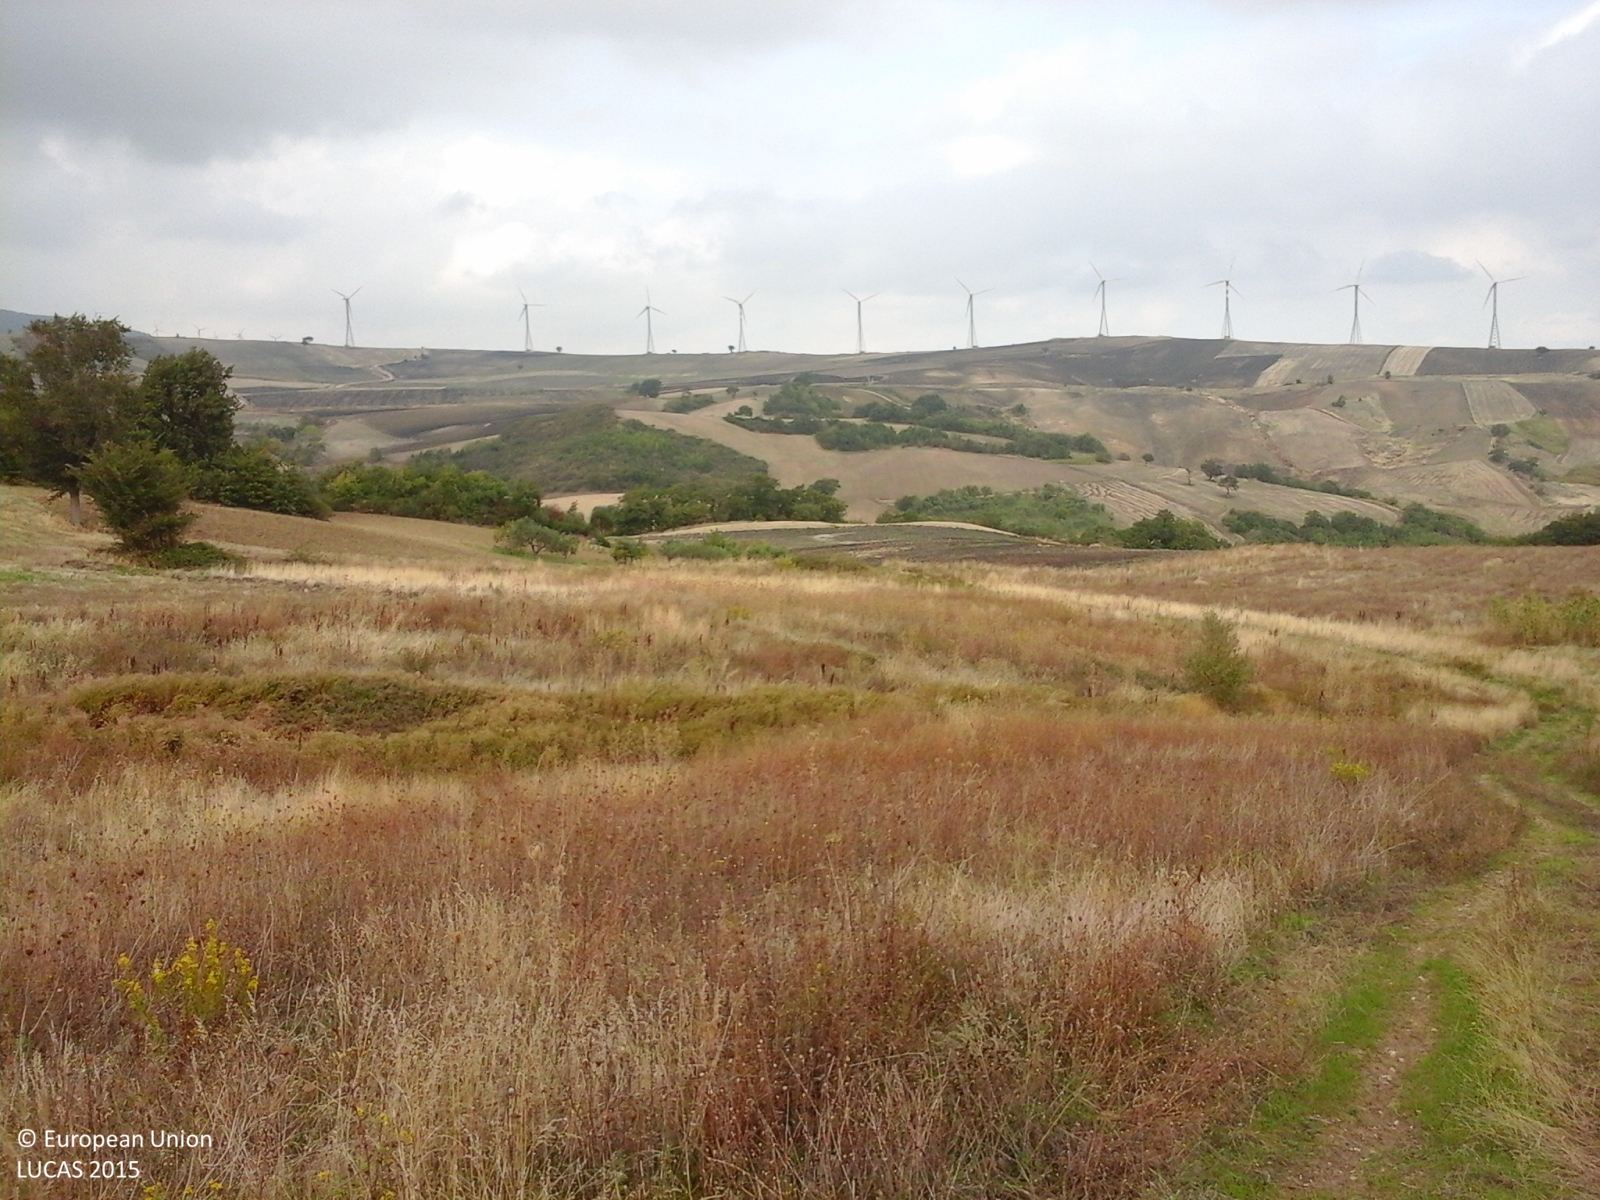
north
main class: Grassland
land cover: Spontaneously vegetated surfaces
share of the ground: > 75 %
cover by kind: herbaceous plants 100 %
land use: Fallow land
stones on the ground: < 10 %
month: October
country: IT
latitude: 41.5107
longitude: 15.1228
